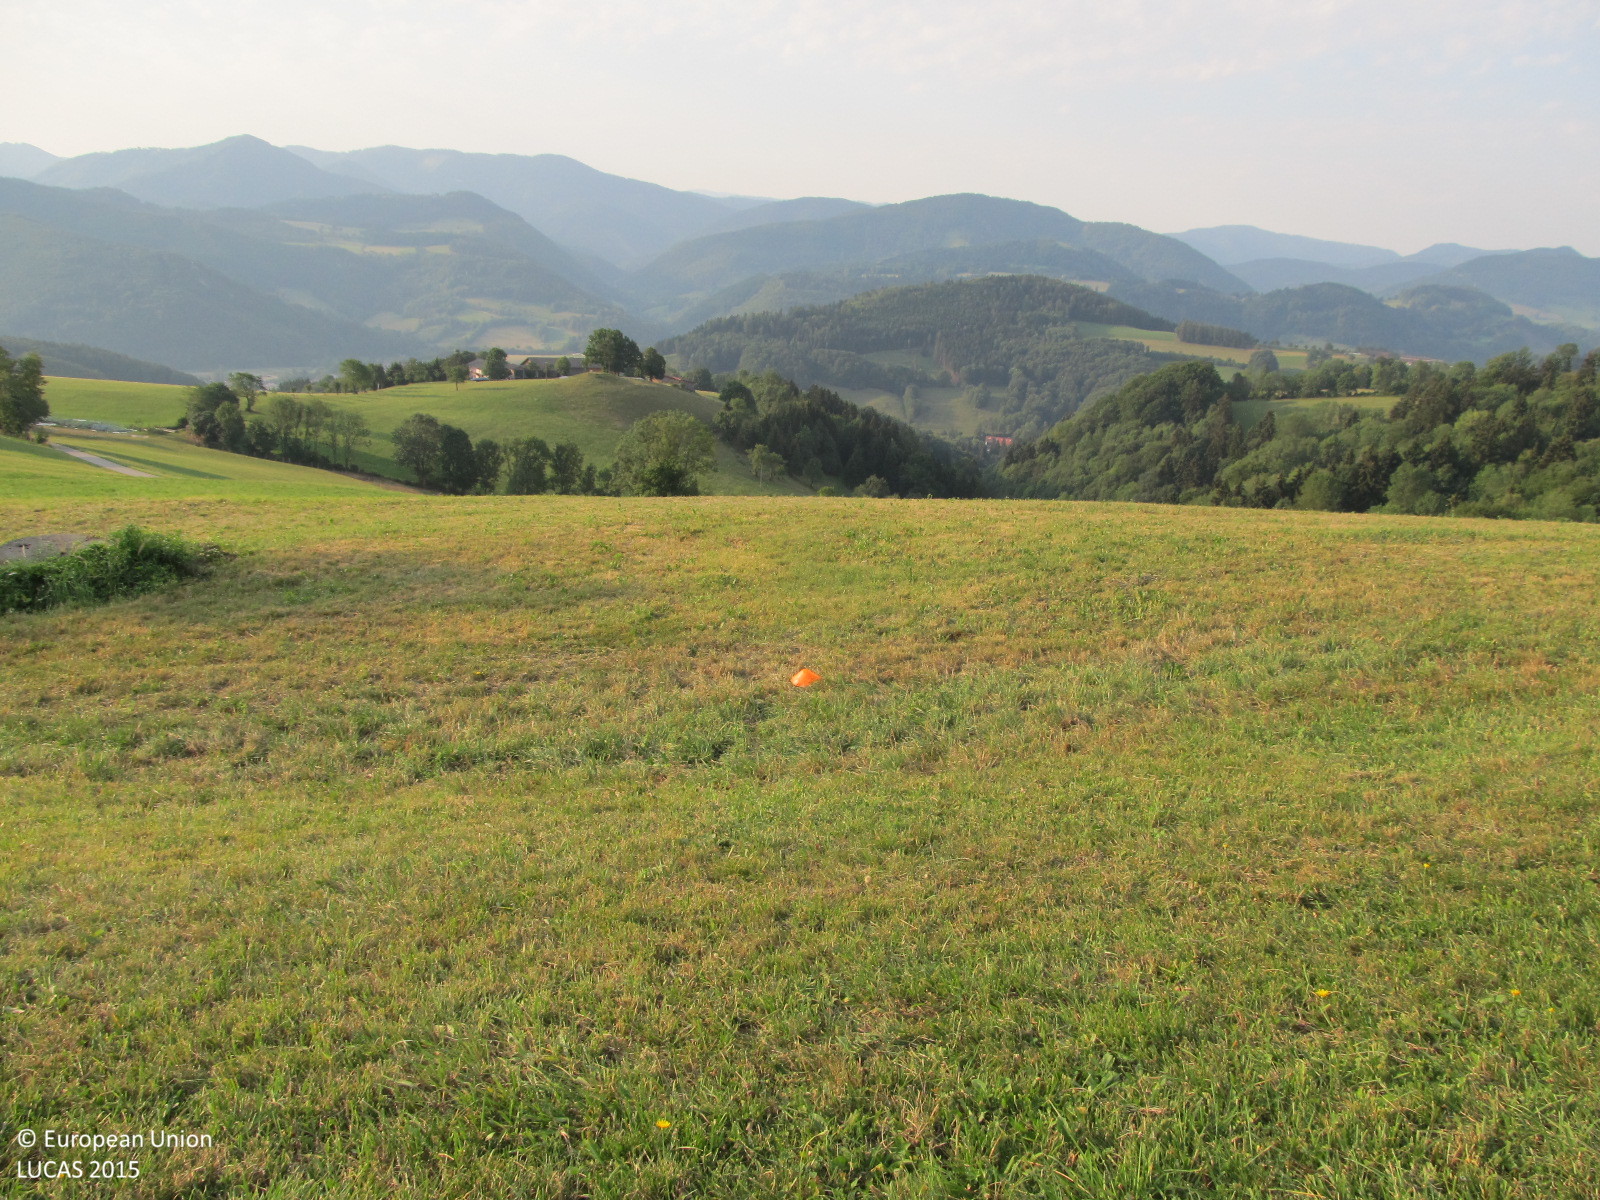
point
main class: Grassland
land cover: Grassland without tree/shrub cover
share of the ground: > 75 %
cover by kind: herbaceous plants 100 %
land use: Agriculture (excluding fallow land and kitchen gardens)
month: August
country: AT
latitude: 48.0381
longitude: 15.3801
